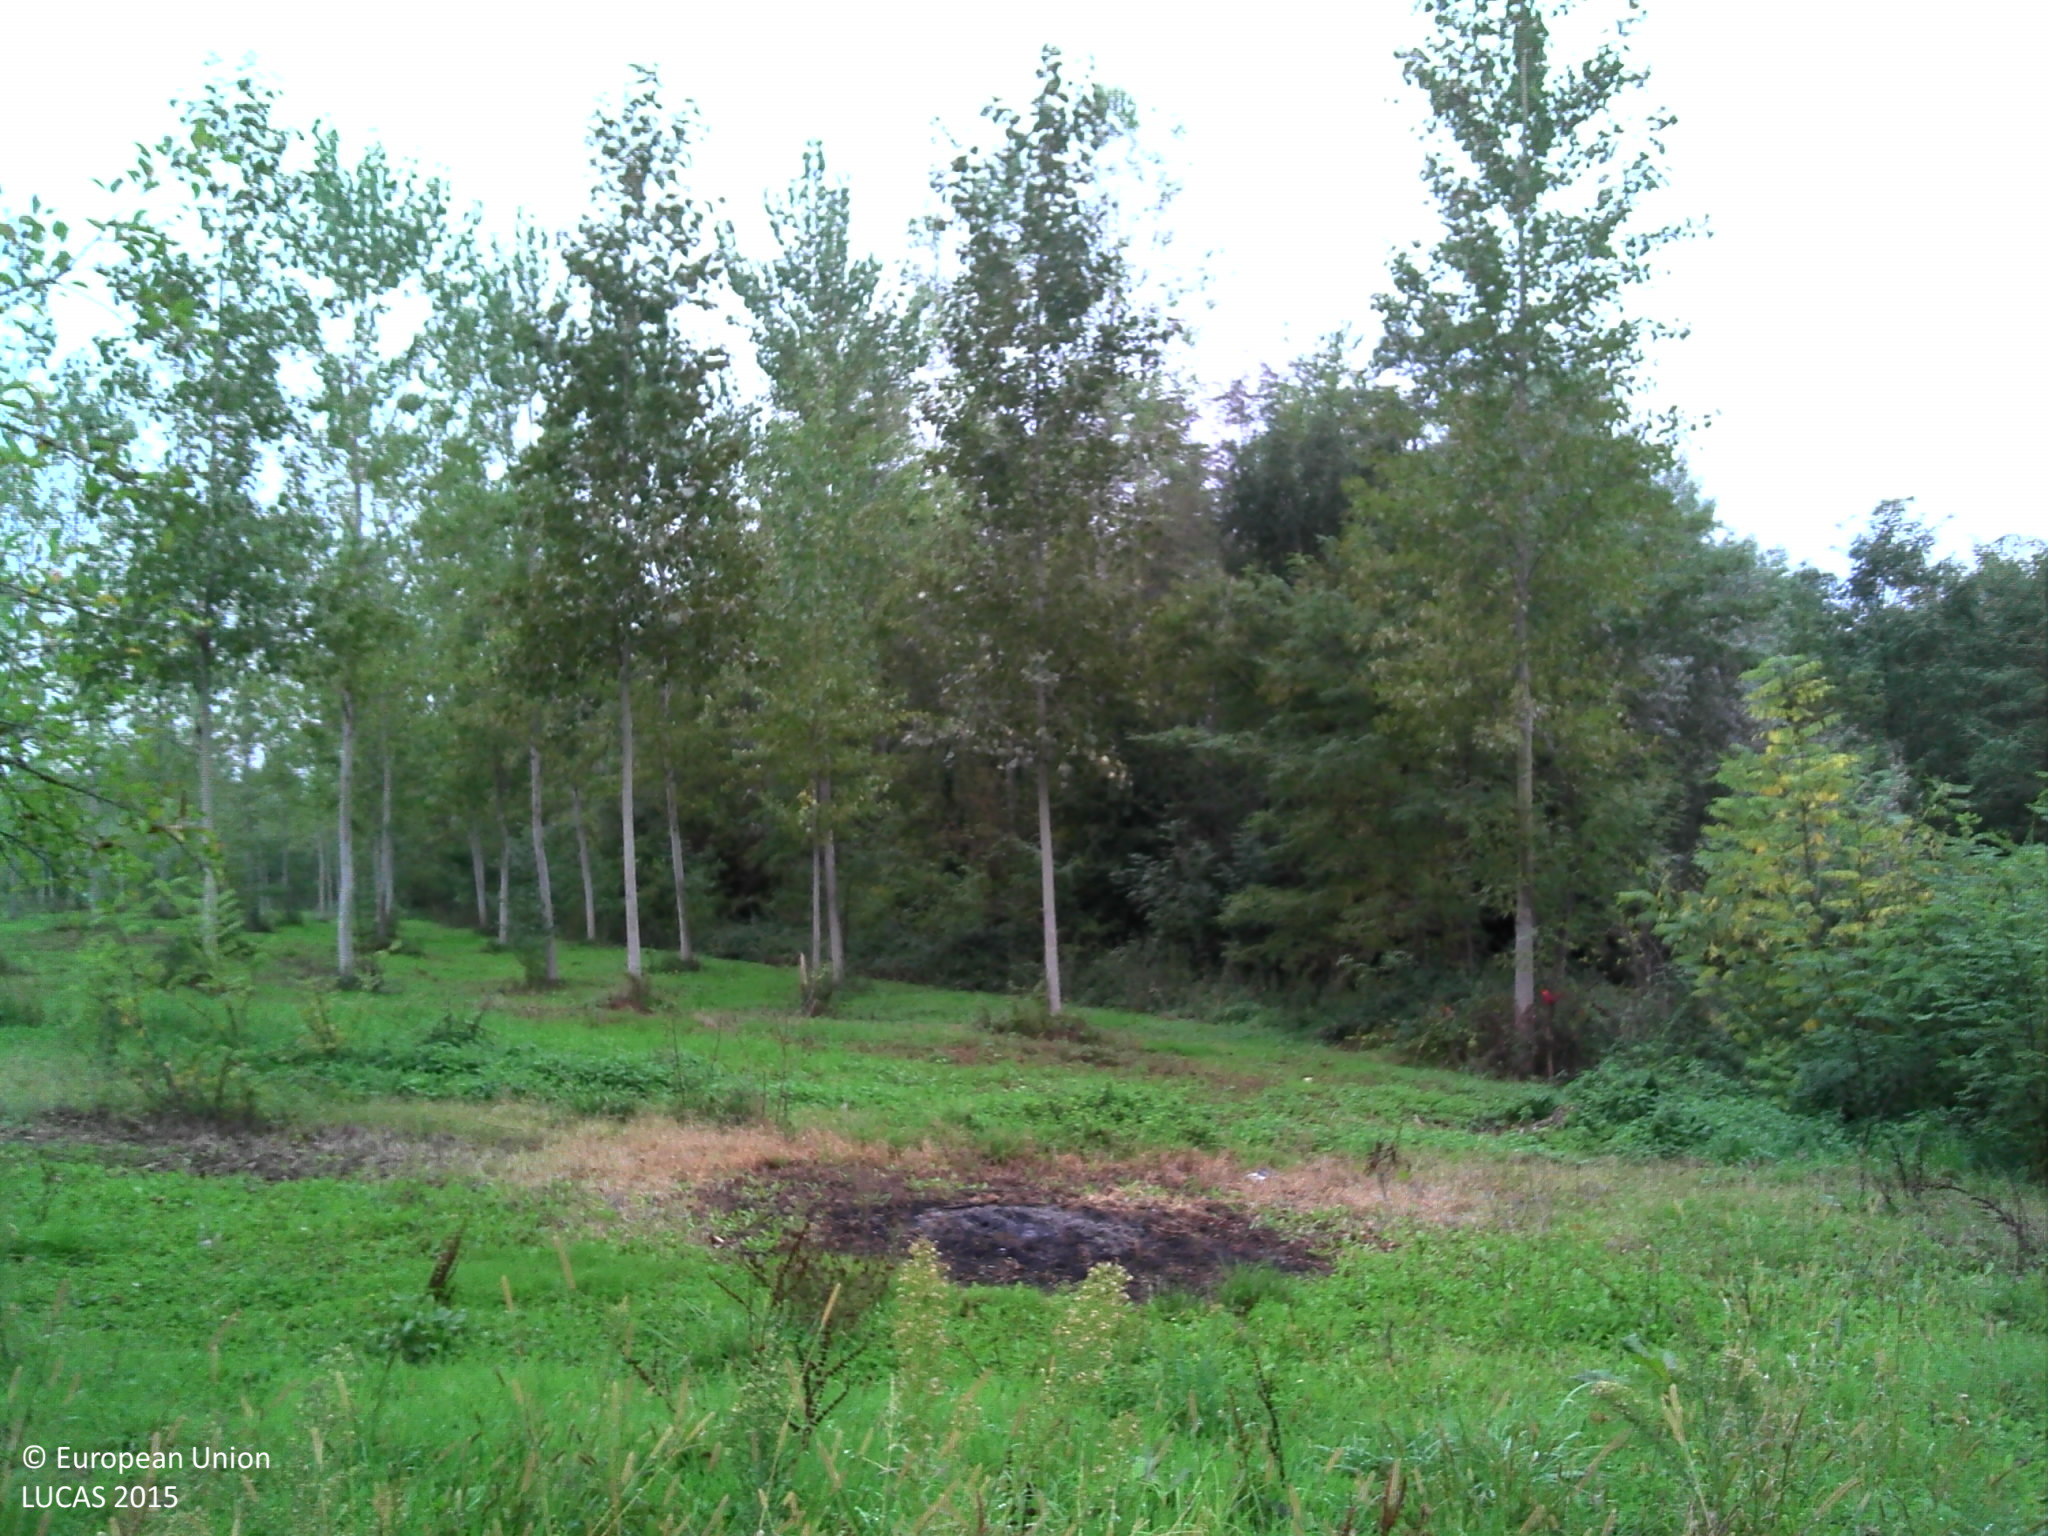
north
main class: Cropland
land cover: Maize
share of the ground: > 75 %
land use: Agriculture (excluding fallow land and kitchen gardens)
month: October
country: FR
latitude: 46.2262
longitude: 4.8293
